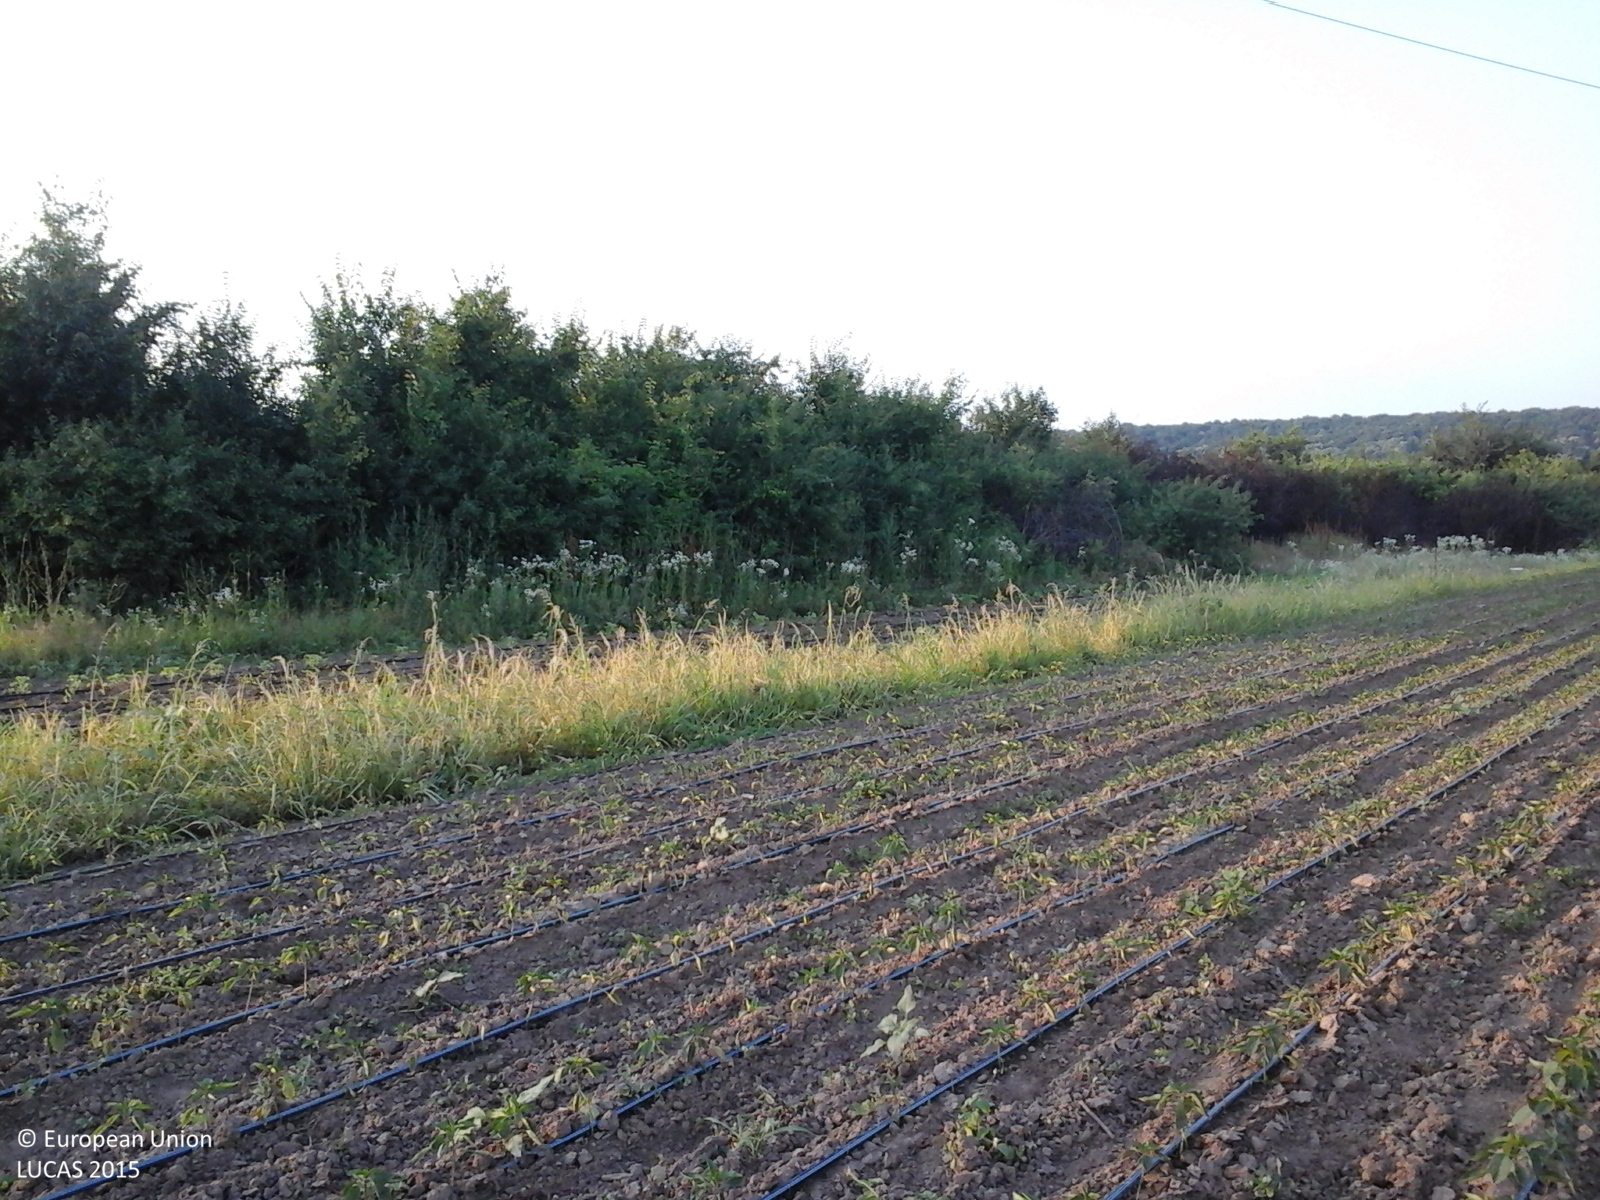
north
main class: Cropland
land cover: Other fresh vegetables
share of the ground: 10 - 25 %
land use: Agriculture (excluding fallow land and kitchen gardens)
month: July
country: RO
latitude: 44.8348
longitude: 25.6964
